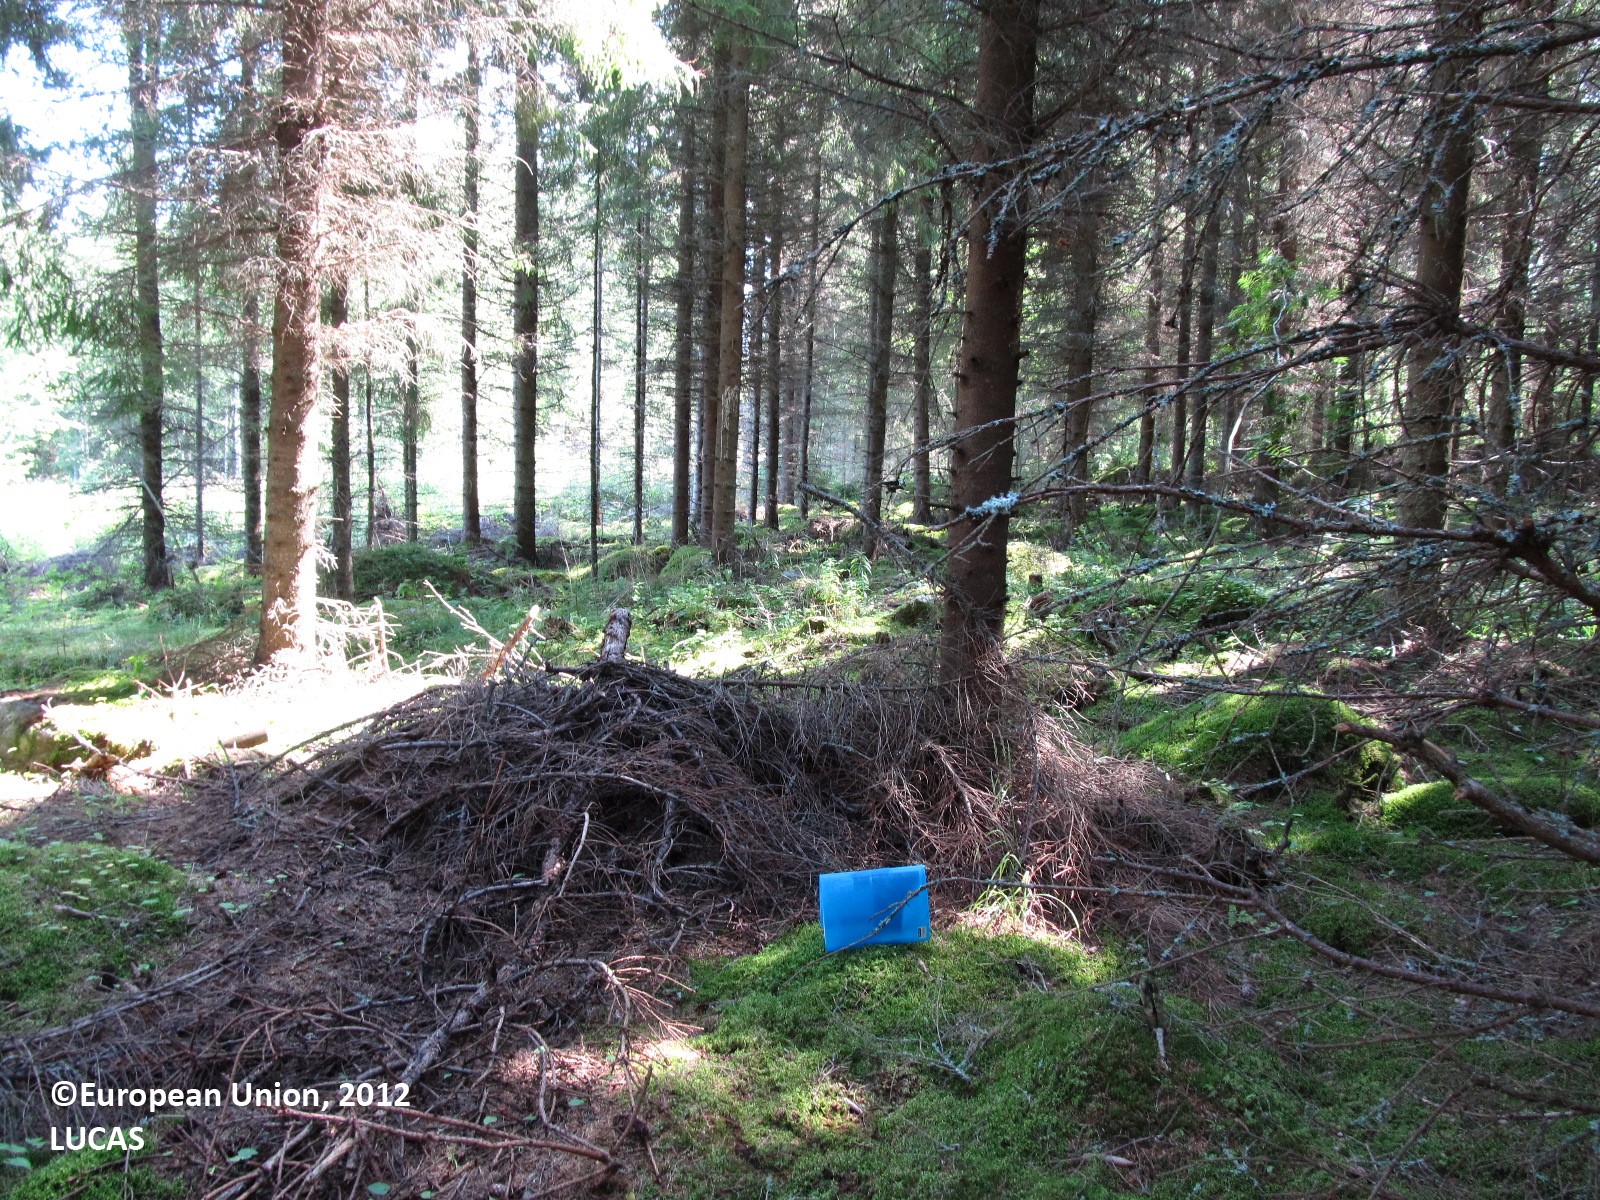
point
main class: Woodland
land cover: Spruce dominated coniferous woodland
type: boreal forest
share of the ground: 25 - 50 %
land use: Forestry
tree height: > 5 m
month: July
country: FI
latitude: 61.9828
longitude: 28.5474
